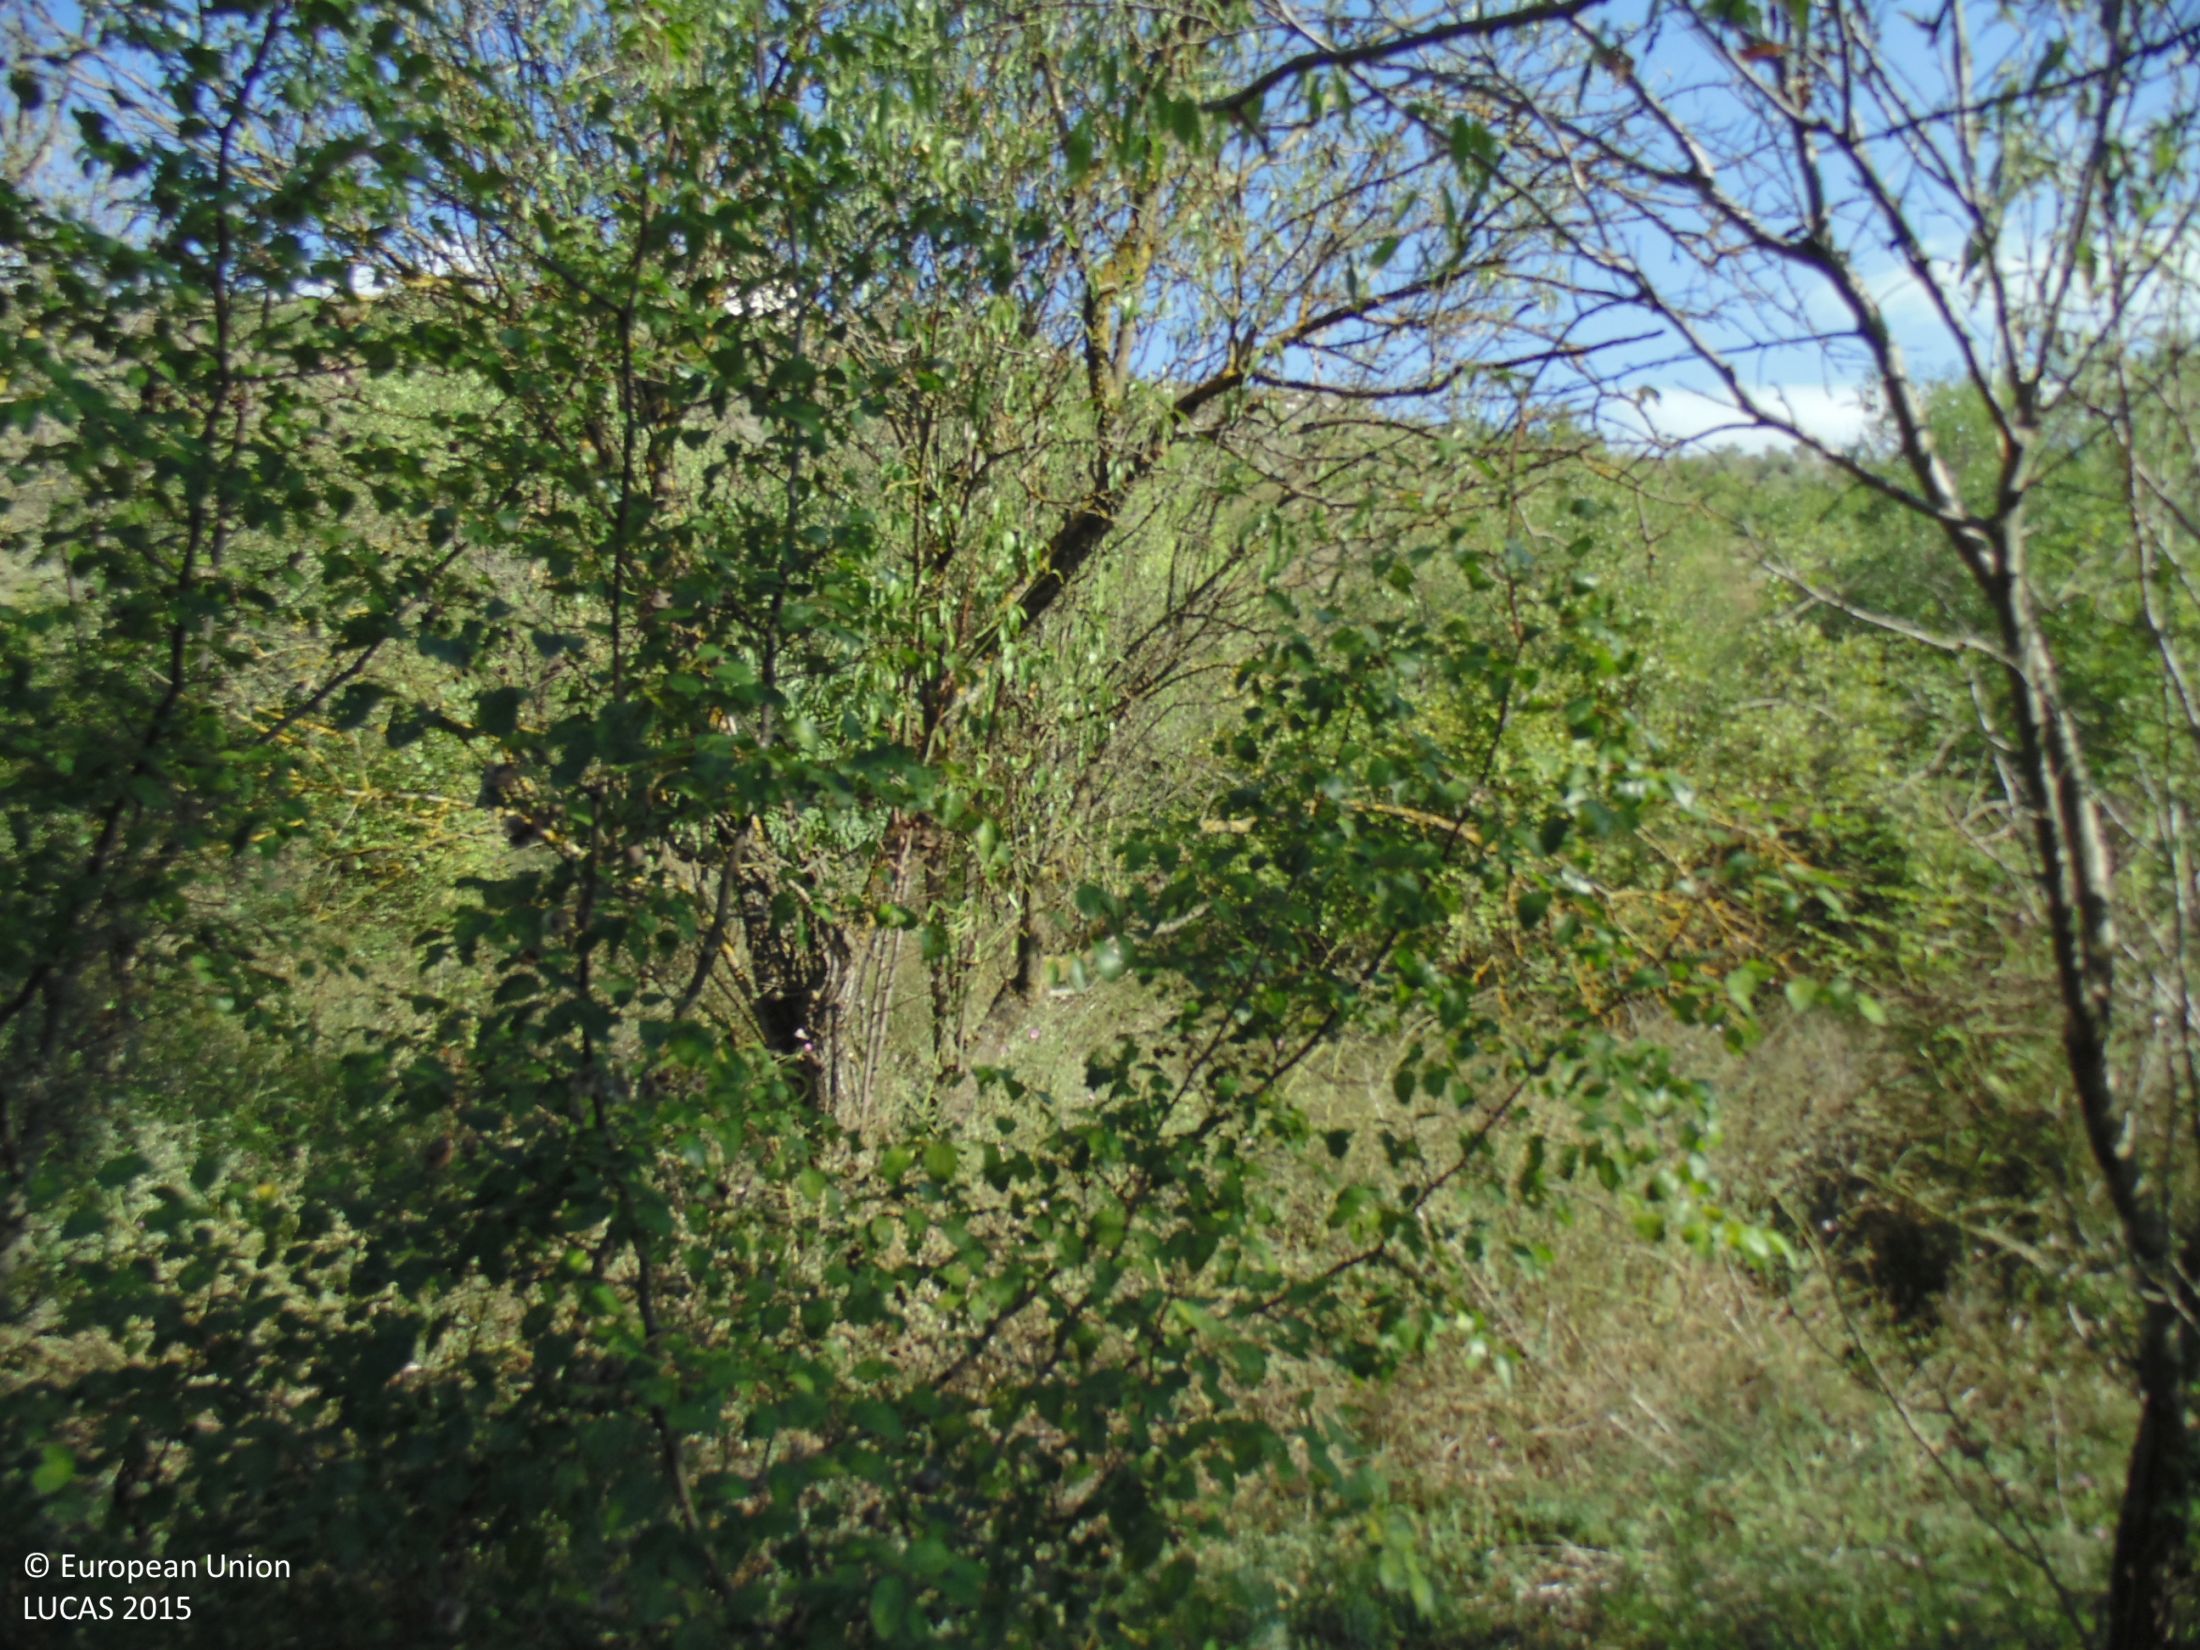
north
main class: Woodland
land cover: Broadleaved woodland
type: mesophytic deciduous forest
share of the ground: > 75 %
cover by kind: broadleaved forest trees 90 %, shrubs 10 %
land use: Forestry
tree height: > 5 m
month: September
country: BG
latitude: 43.4130
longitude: 28.2697
